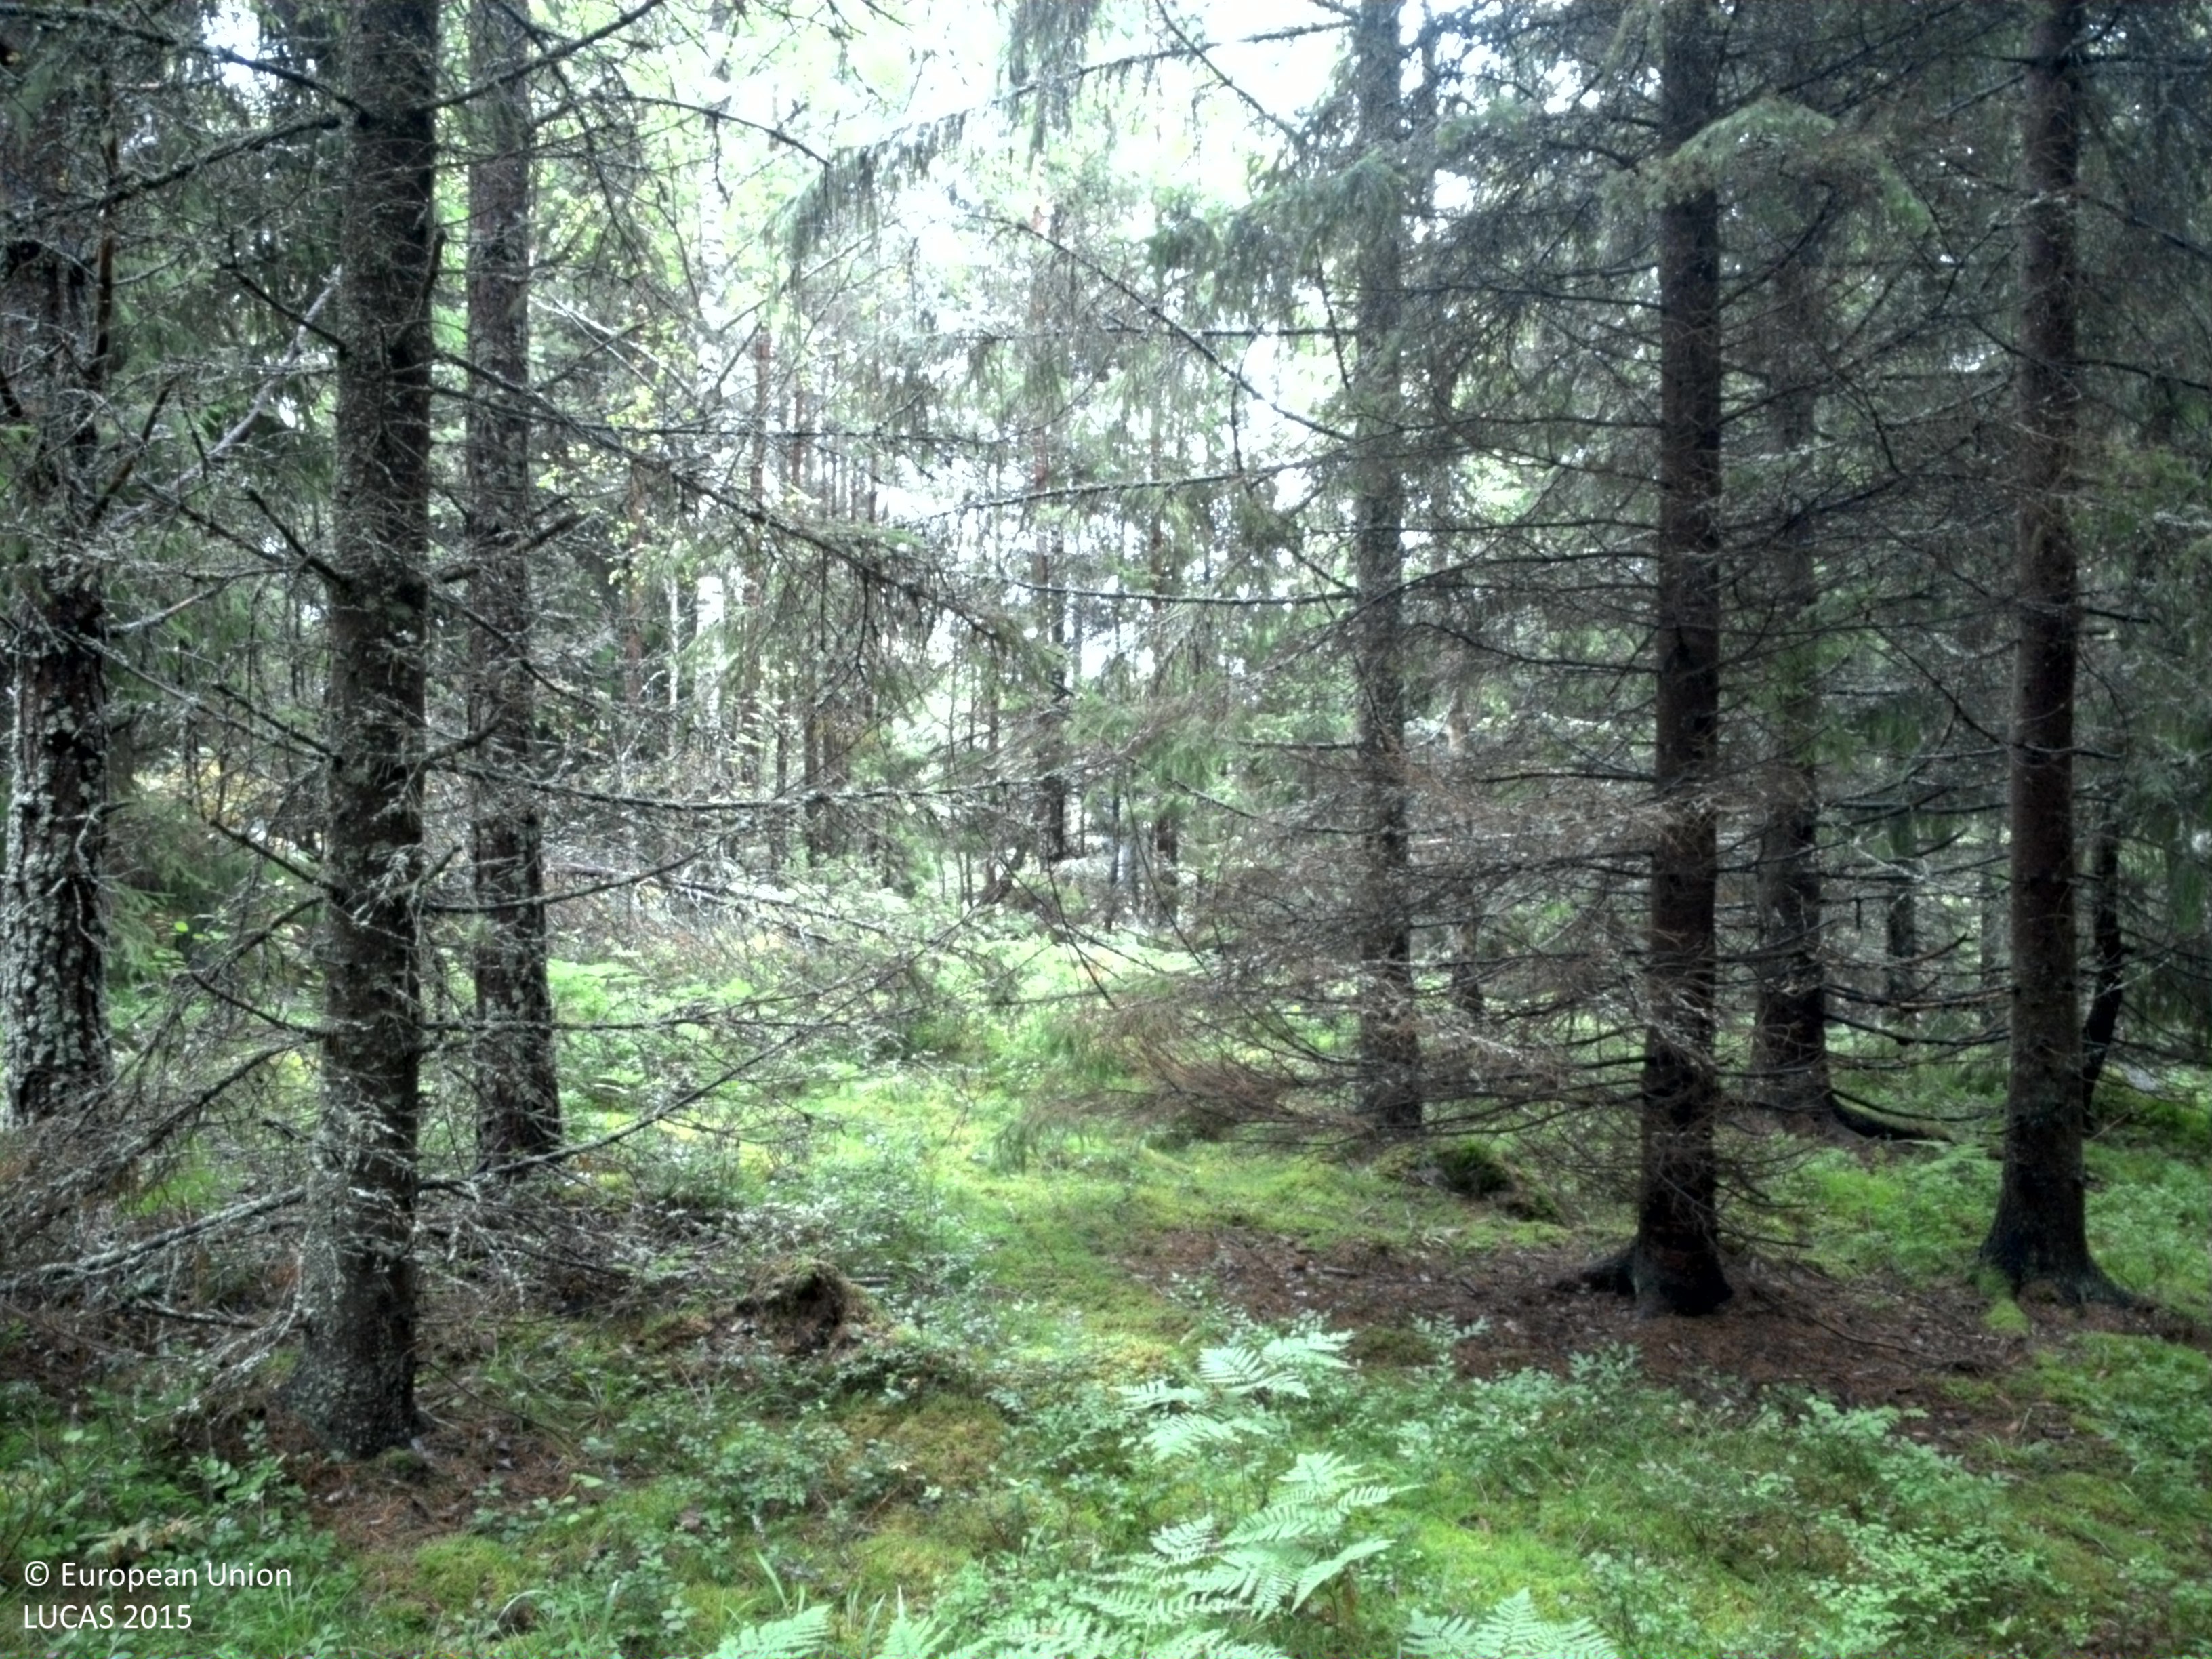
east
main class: Woodland
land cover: Spruce dominated coniferous woodland
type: boreal forest
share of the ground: 50 - 75 %
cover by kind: coniferous forest trees 60 %, lichens and mosses 35 %, broadleaved forest trees 5 %
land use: Forestry
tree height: > 5 m
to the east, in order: Spruce dominated coniferous woodland; Ditches and canals; Paved roads, cycling and walking lanes; Electric lines; Ditches and canals; Grassland without tree/shrub cover; Ditches and canals; Spruce dominated coniferous woodland; Spruce dominated mixed woodland; Pine dominated mixed woodland; Other coniferous woodland
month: July
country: SE
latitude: 59.6748
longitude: 18.7188
